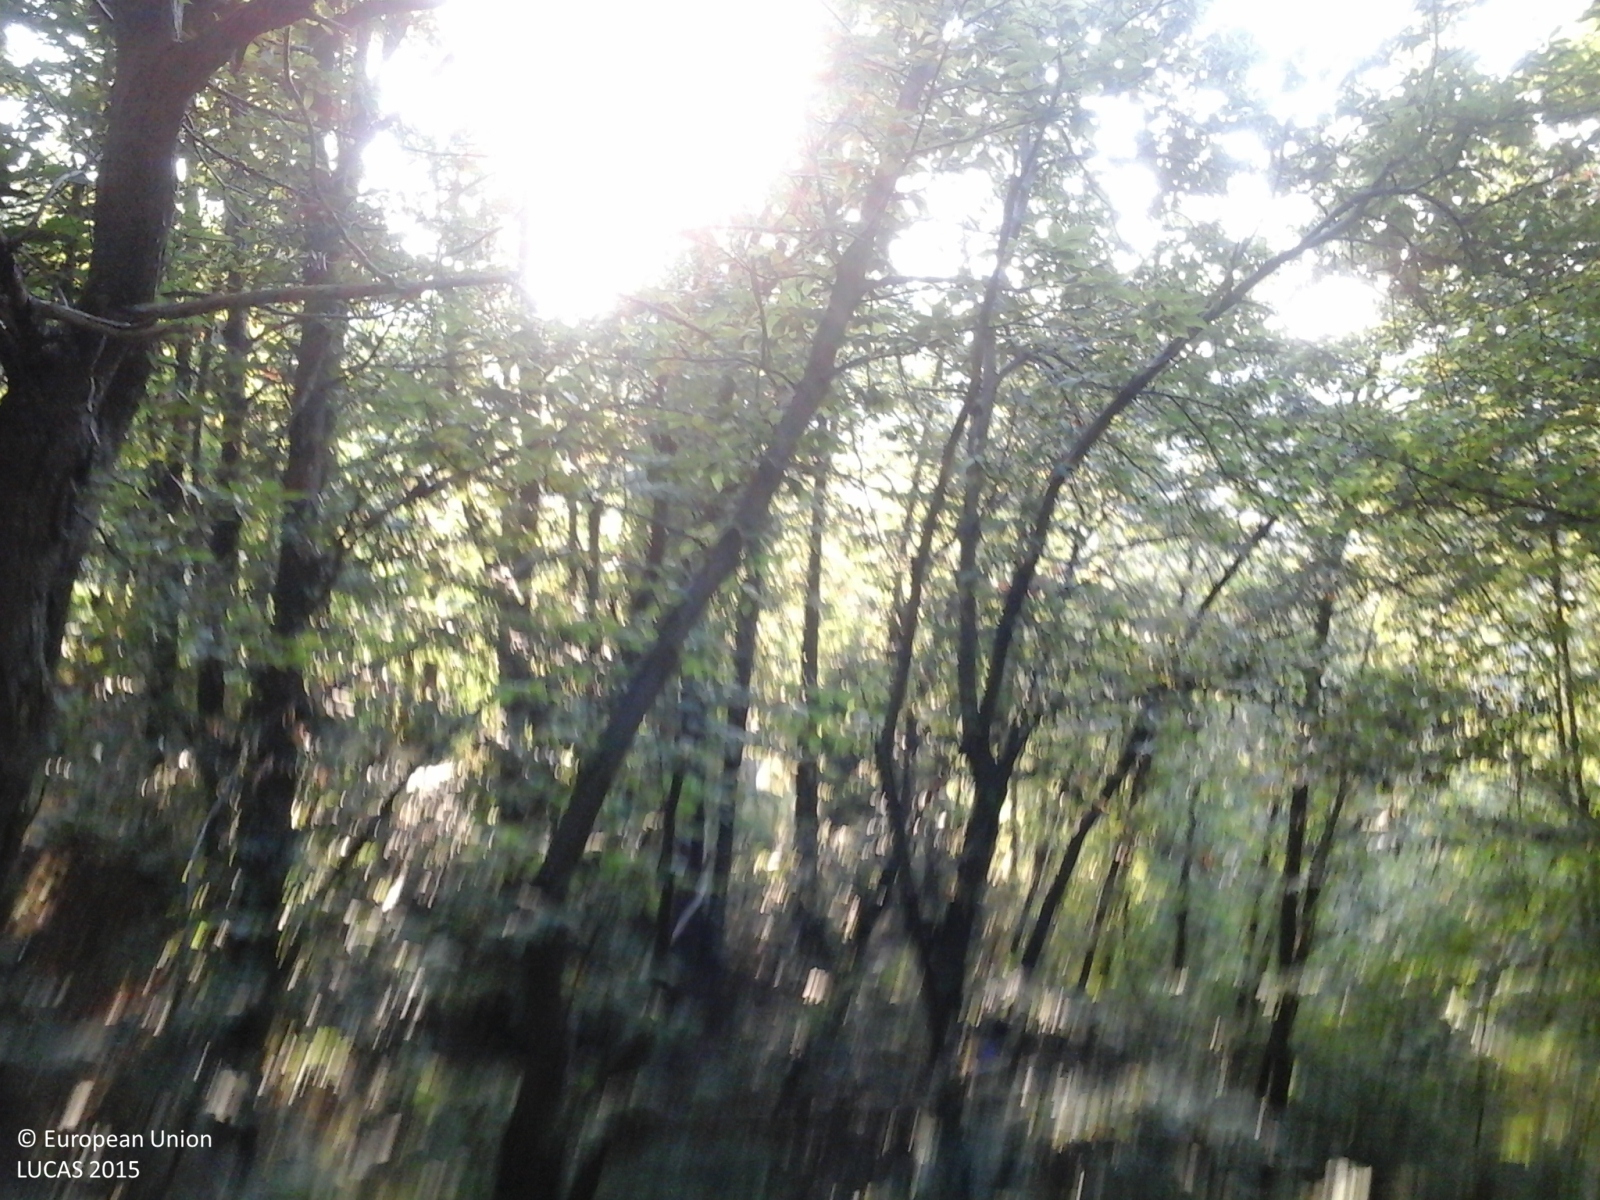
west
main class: Woodland
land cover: Broadleaved woodland
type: thermophilous deciduous forest
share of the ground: > 75 %
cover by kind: broadleaved forest trees 100 %
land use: Semi-natural and natural areas not in use
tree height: > 5 m
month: September
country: IT
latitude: 44.3184
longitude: 8.2861
